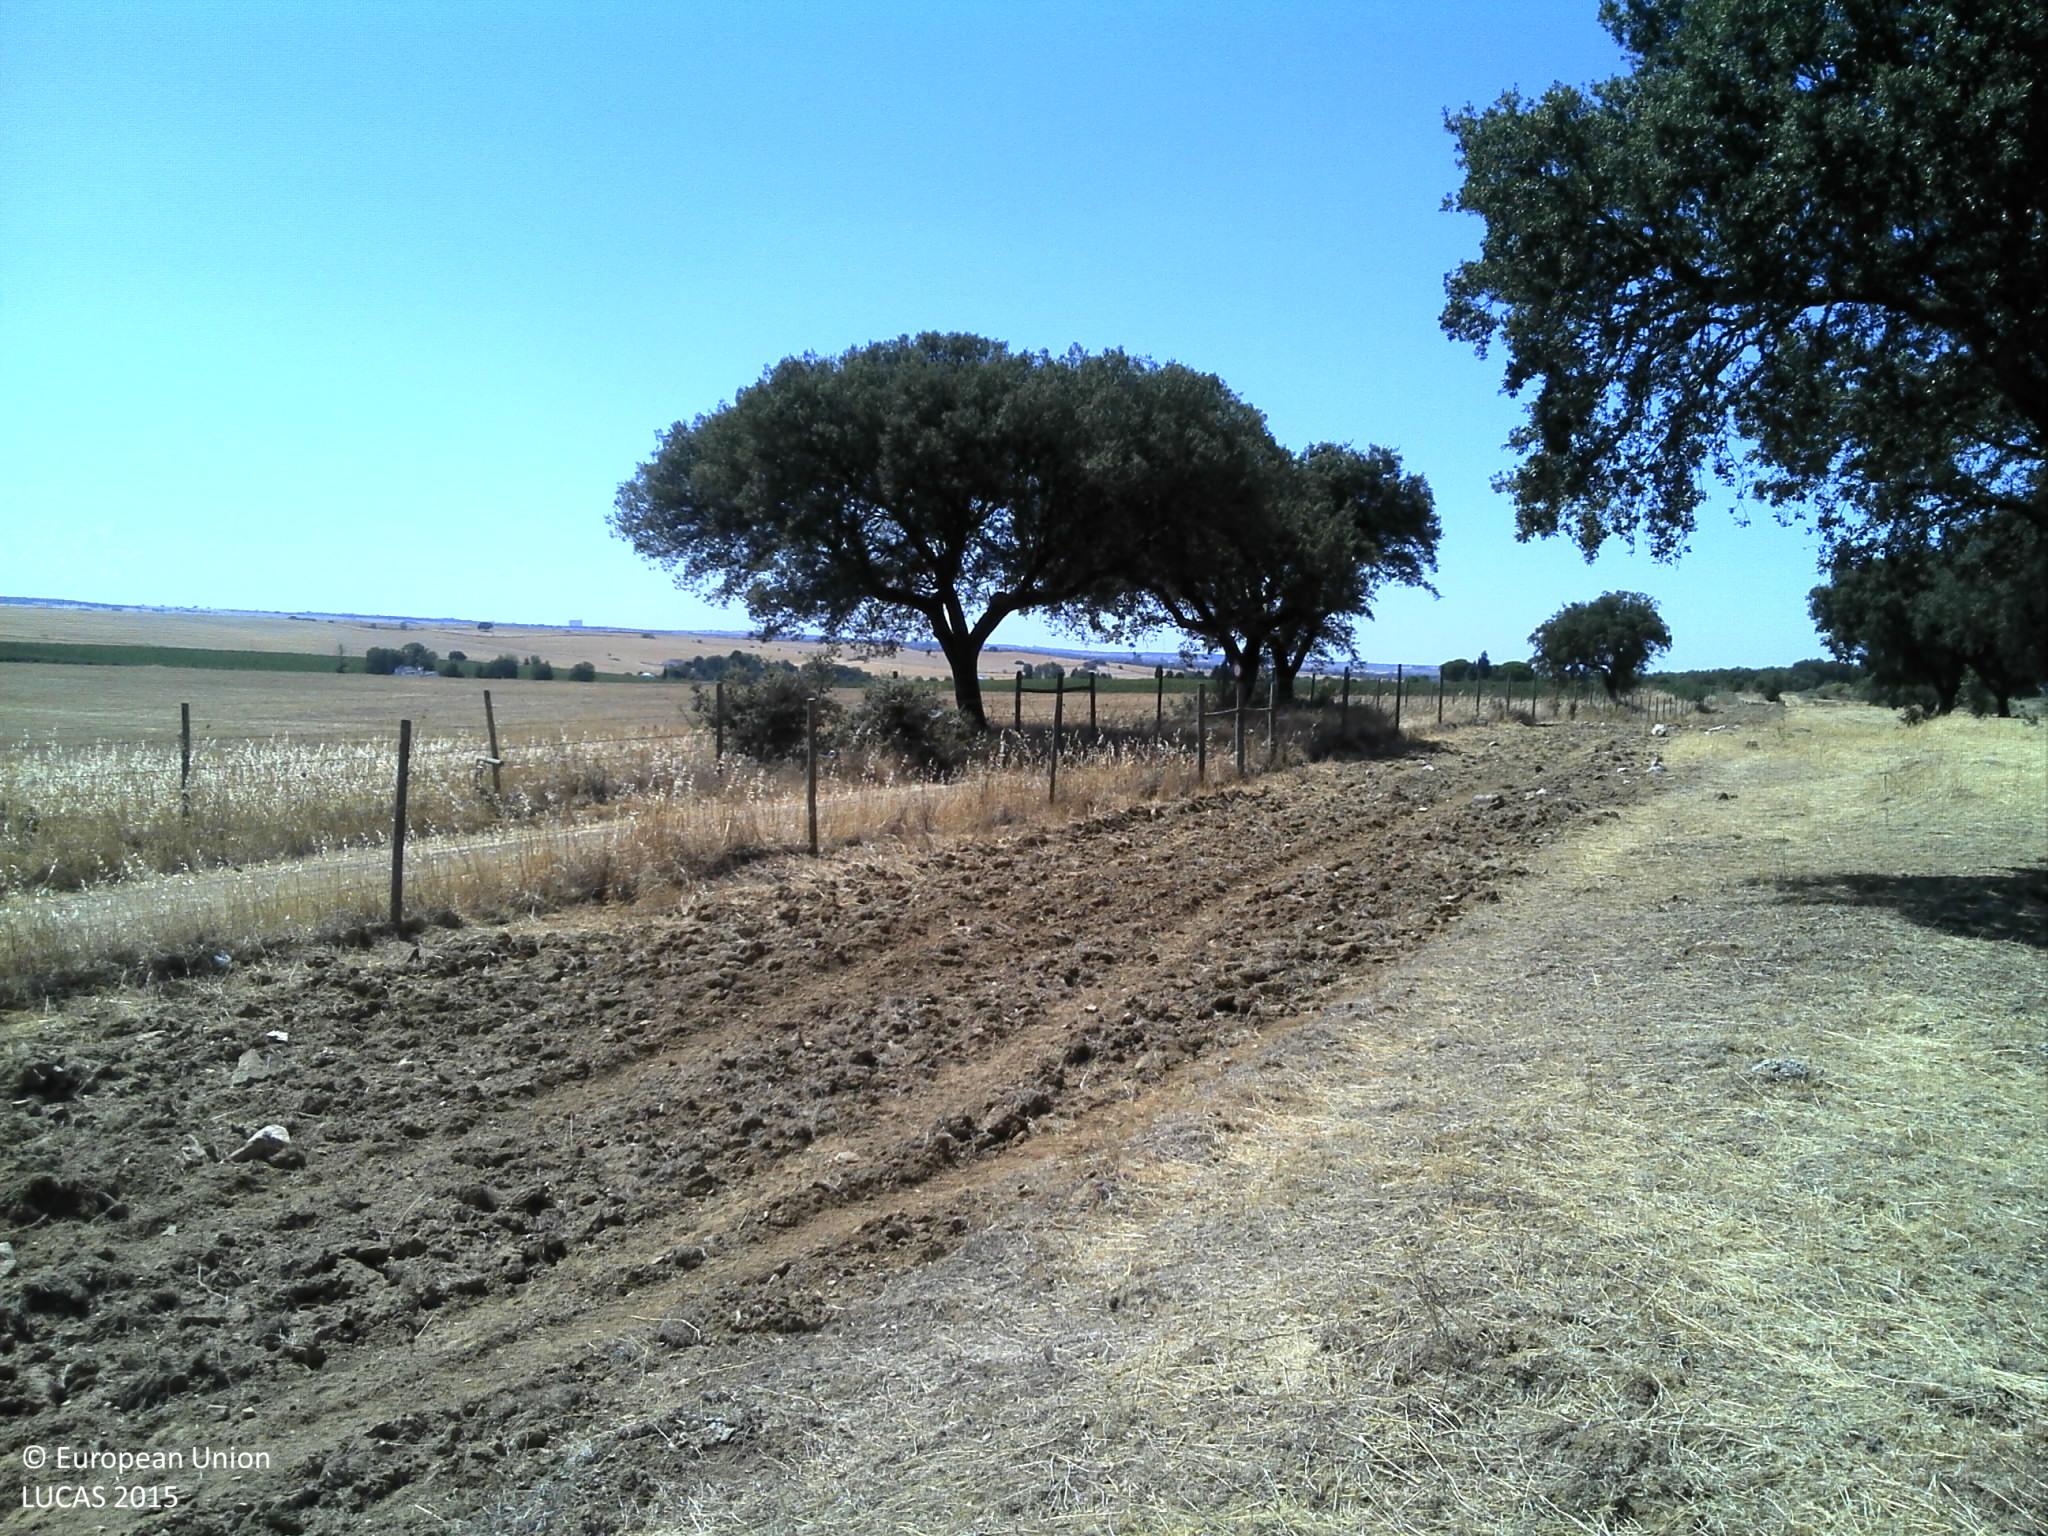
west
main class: Woodland
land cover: Broadleaved woodland
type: broadleaved evergreen forest
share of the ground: 25 - 50 %
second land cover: Grassland without tree/shrub cover
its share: 10 - 25 %
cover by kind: unconsolidated bare surface 55 %, broadleaved forest trees 25 %, herbaceous plants 20 %
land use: Forestry
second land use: Agriculture (excluding fallow land and kitchen gardens)
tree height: > 5 m
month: July
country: PT
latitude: 39.0243
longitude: -7.5384
